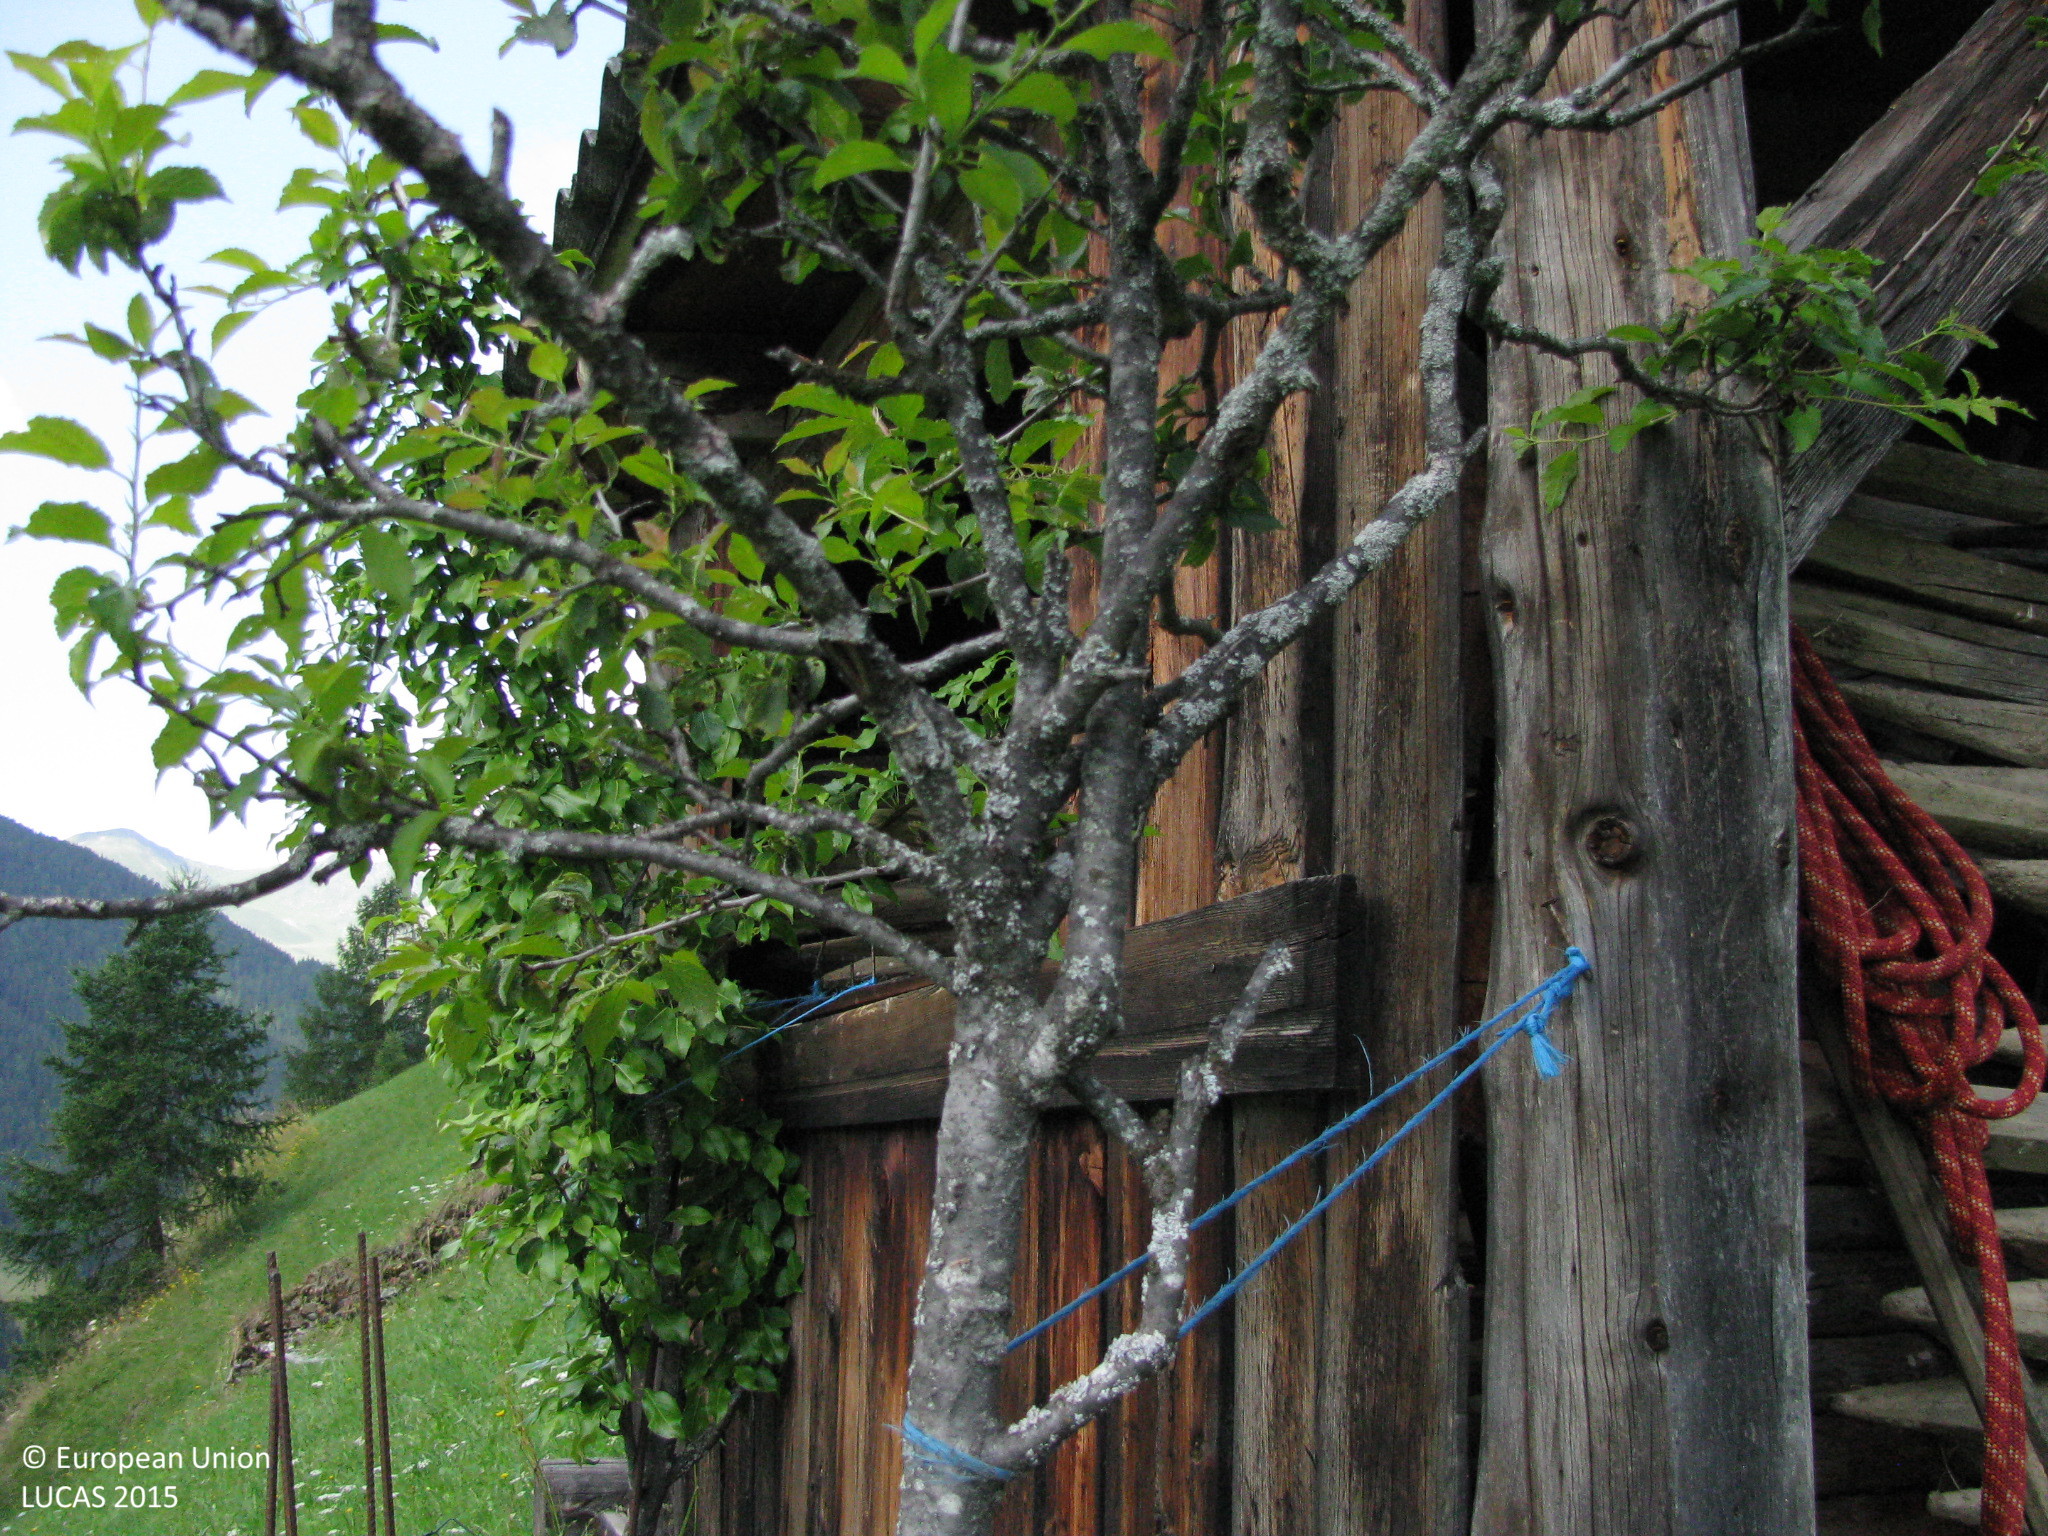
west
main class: Grassland
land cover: Grassland with sparse tree/shrub cover
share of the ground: > 75 %
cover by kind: herbaceous plants 95 %, broadleaved forest trees 5 %
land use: Agriculture (excluding fallow land and kitchen gardens)
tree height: < 5 m
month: July
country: AT
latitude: 46.8114
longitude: 12.3698
